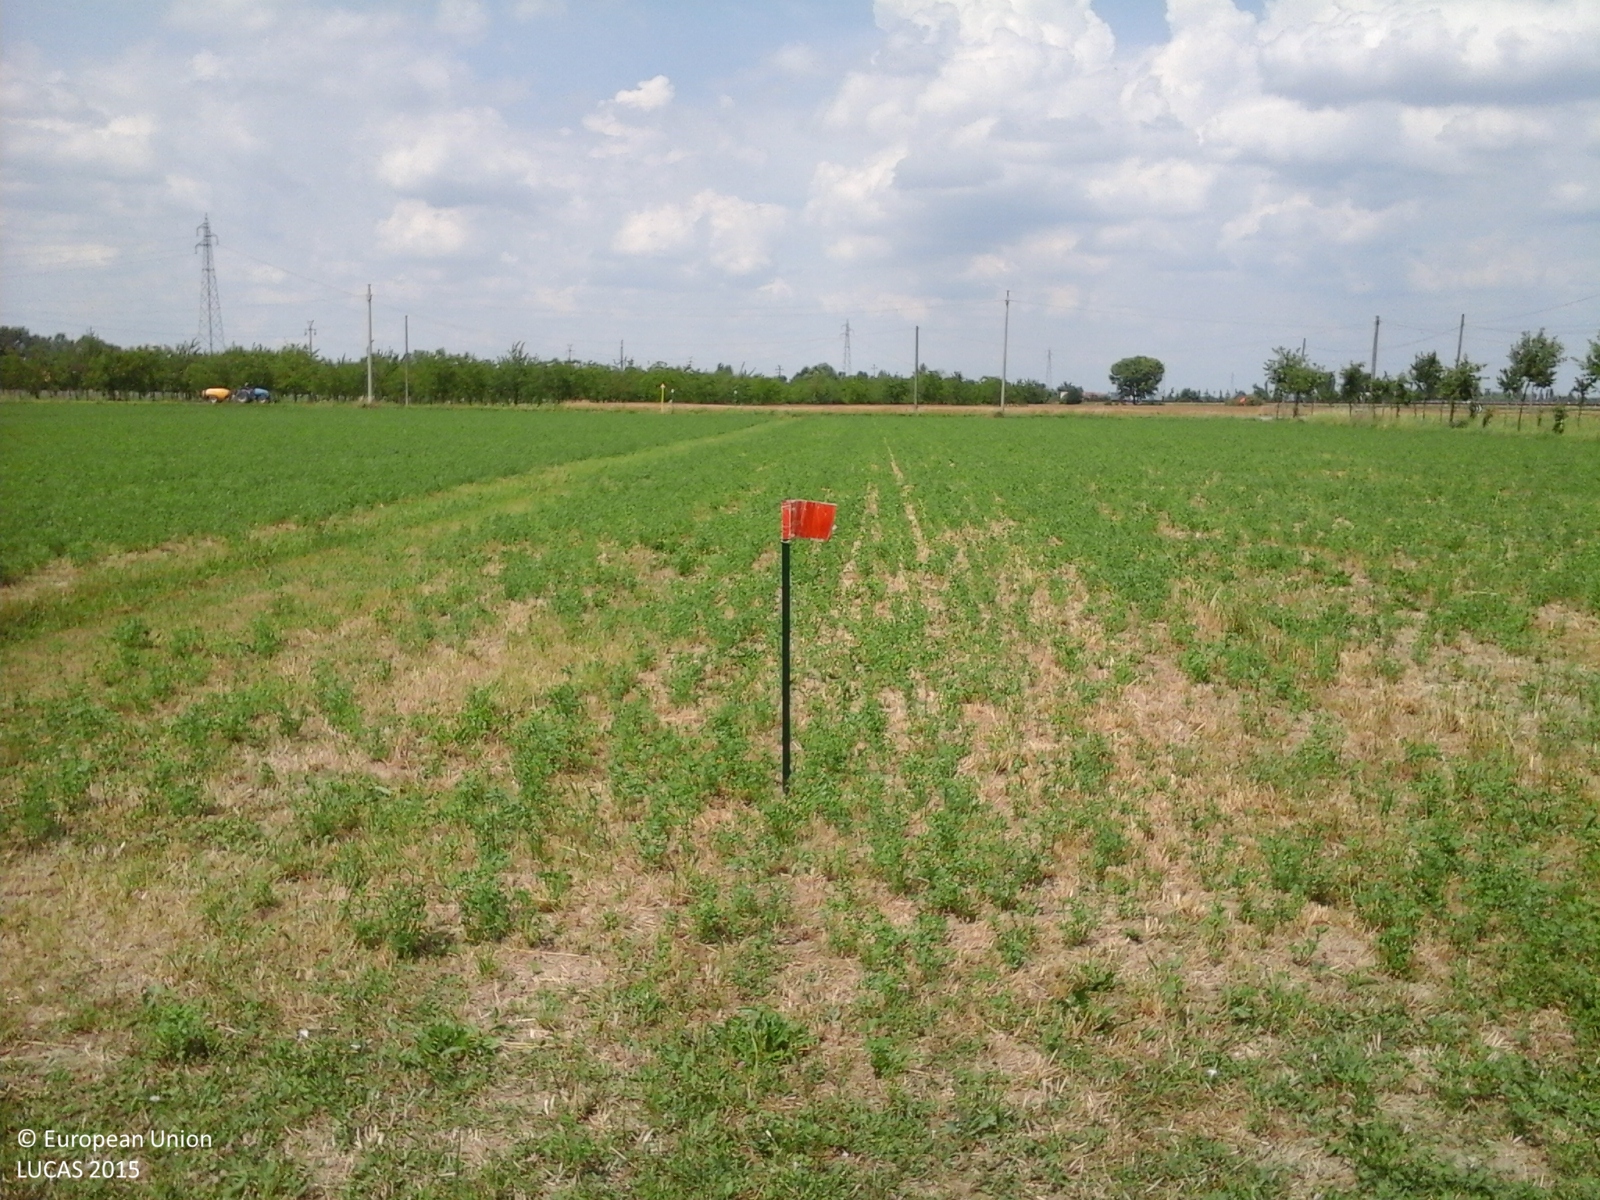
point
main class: Cropland
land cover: Lucerne
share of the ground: > 75 %
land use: Agriculture (excluding fallow land and kitchen gardens)
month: June
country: IT
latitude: 44.7078
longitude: 10.8439
